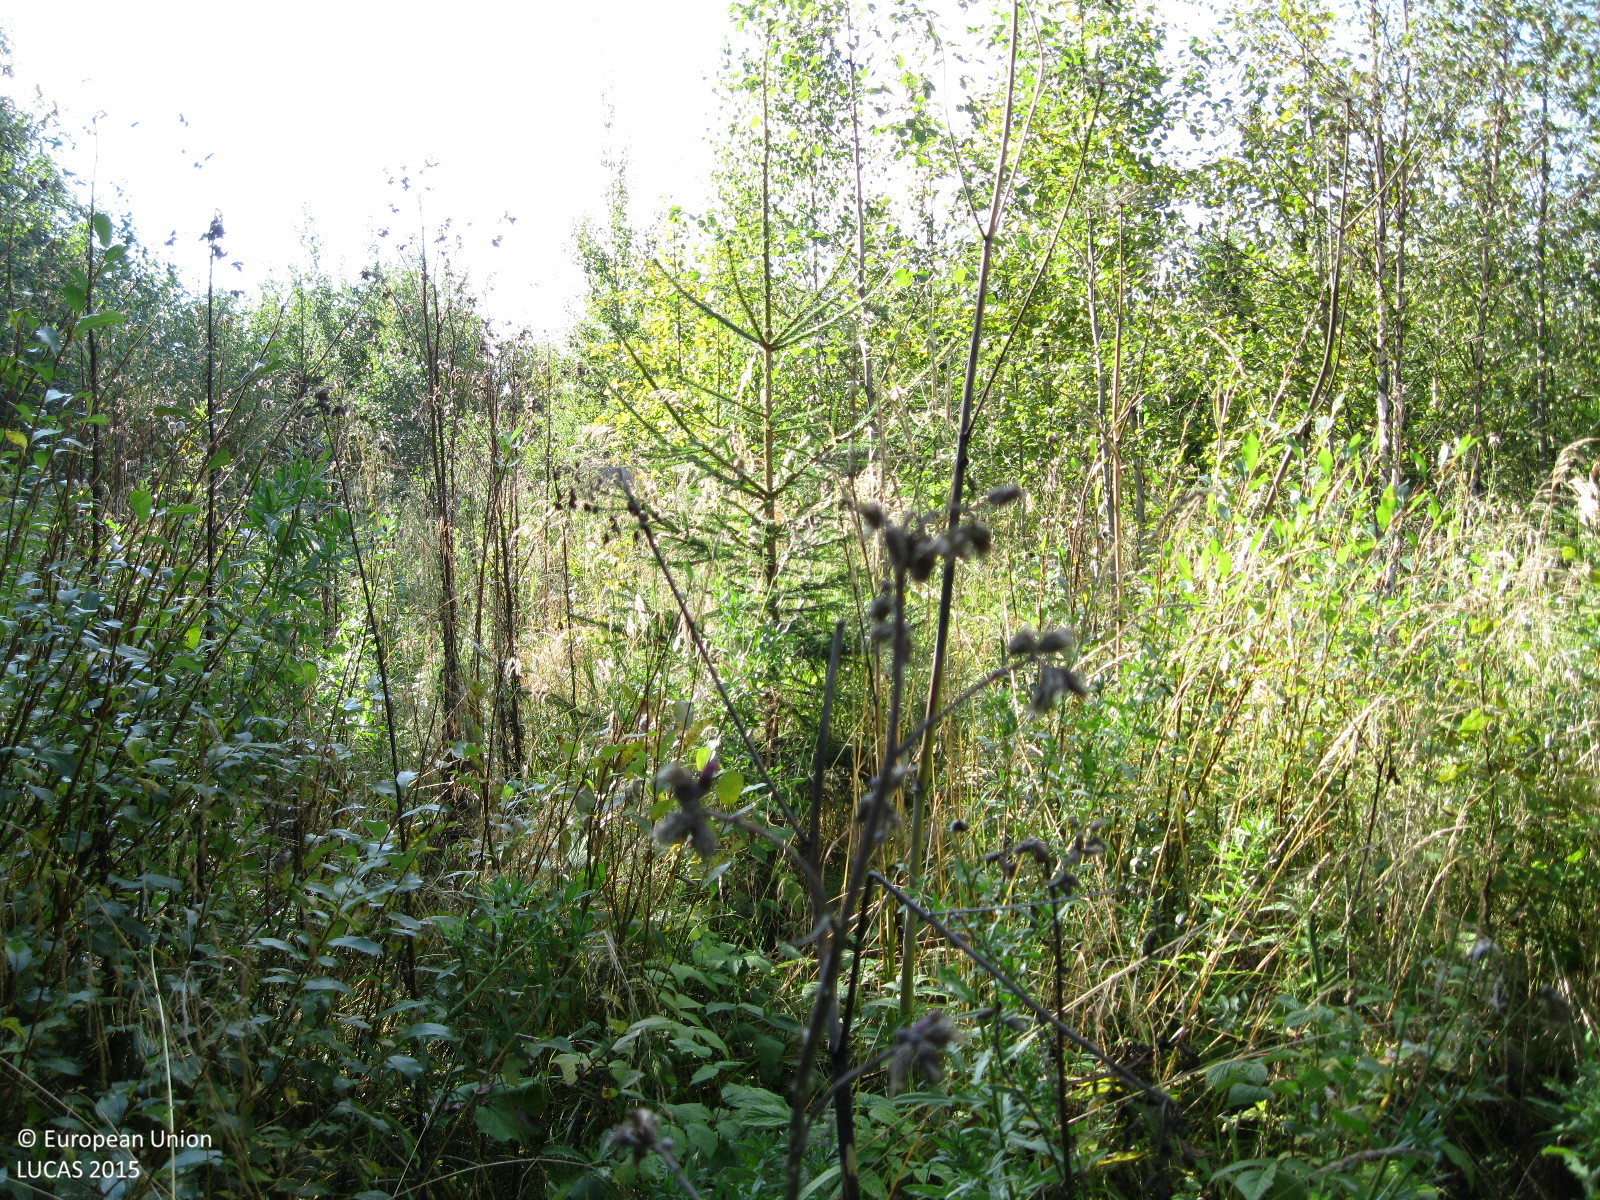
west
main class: Woodland
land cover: Broadleaved woodland
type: boreal forest
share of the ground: > 75 %
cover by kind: broadleaved forest trees 80 %, herbaceous plants 15 %, coniferous forest trees 5 %
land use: Forestry
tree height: > 5 m
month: September
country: FI
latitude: 60.5092
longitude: 24.8463
